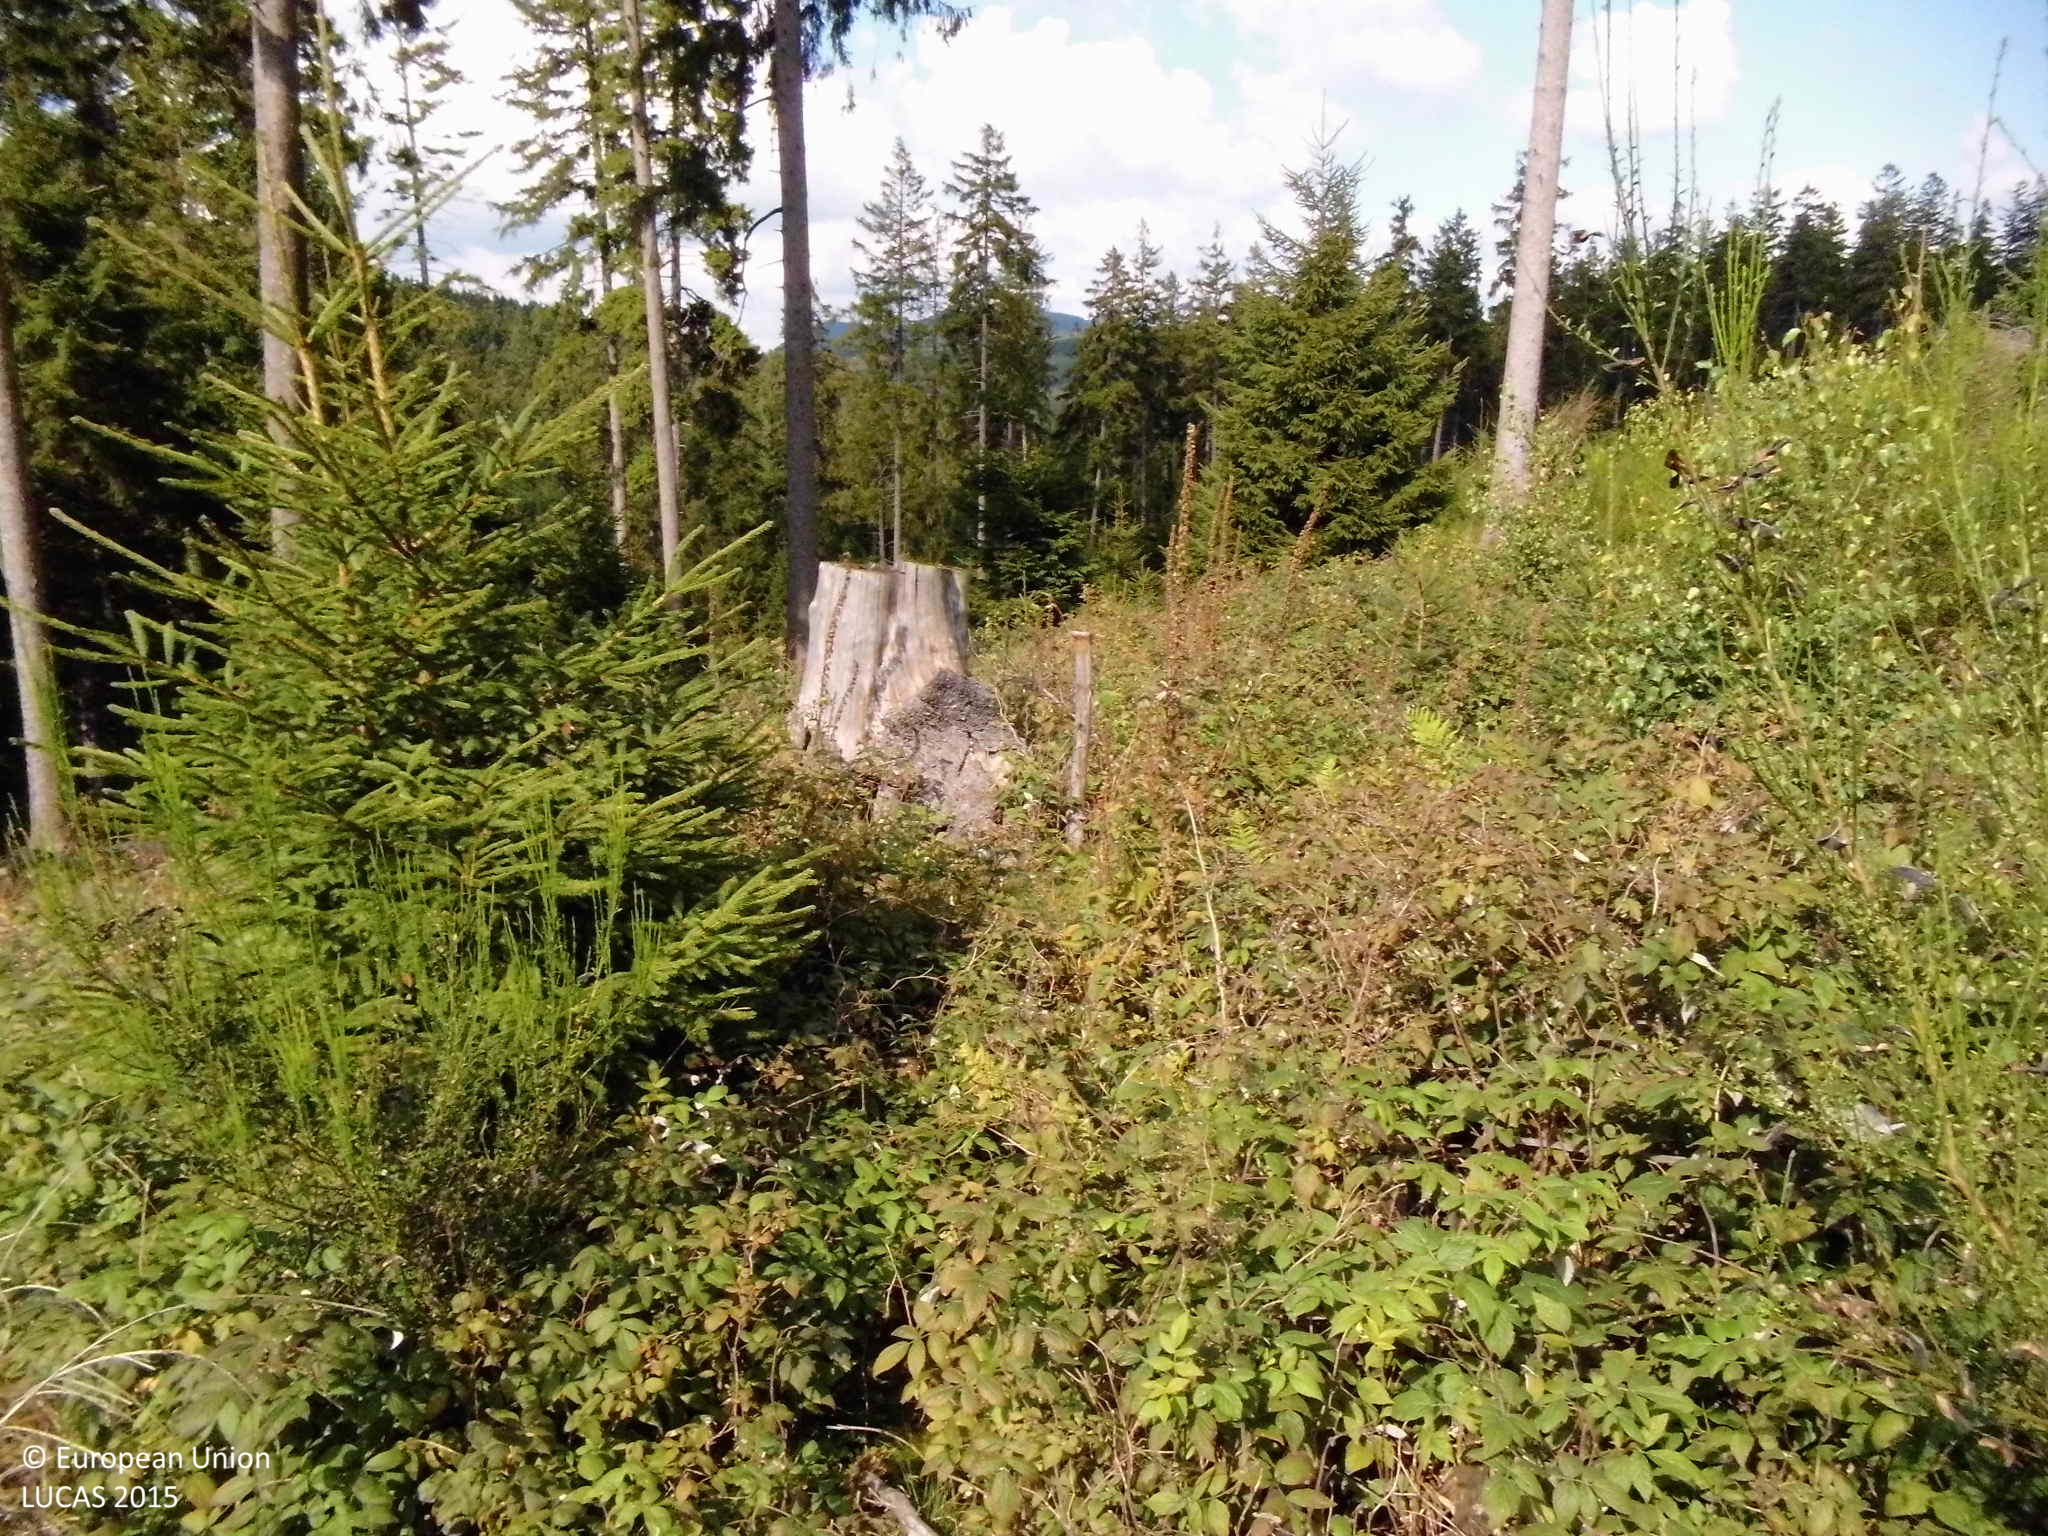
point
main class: Shrubland
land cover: Shrubland with sparse tree cover
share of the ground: > 75 %
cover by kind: shrubs 50 %, herbaceous plants 25 %, lichens and mosses 20 %, coniferous forest trees 5 %
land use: Forestry
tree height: < 5 m
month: September
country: DE
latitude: 51.2888
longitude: 8.4661
